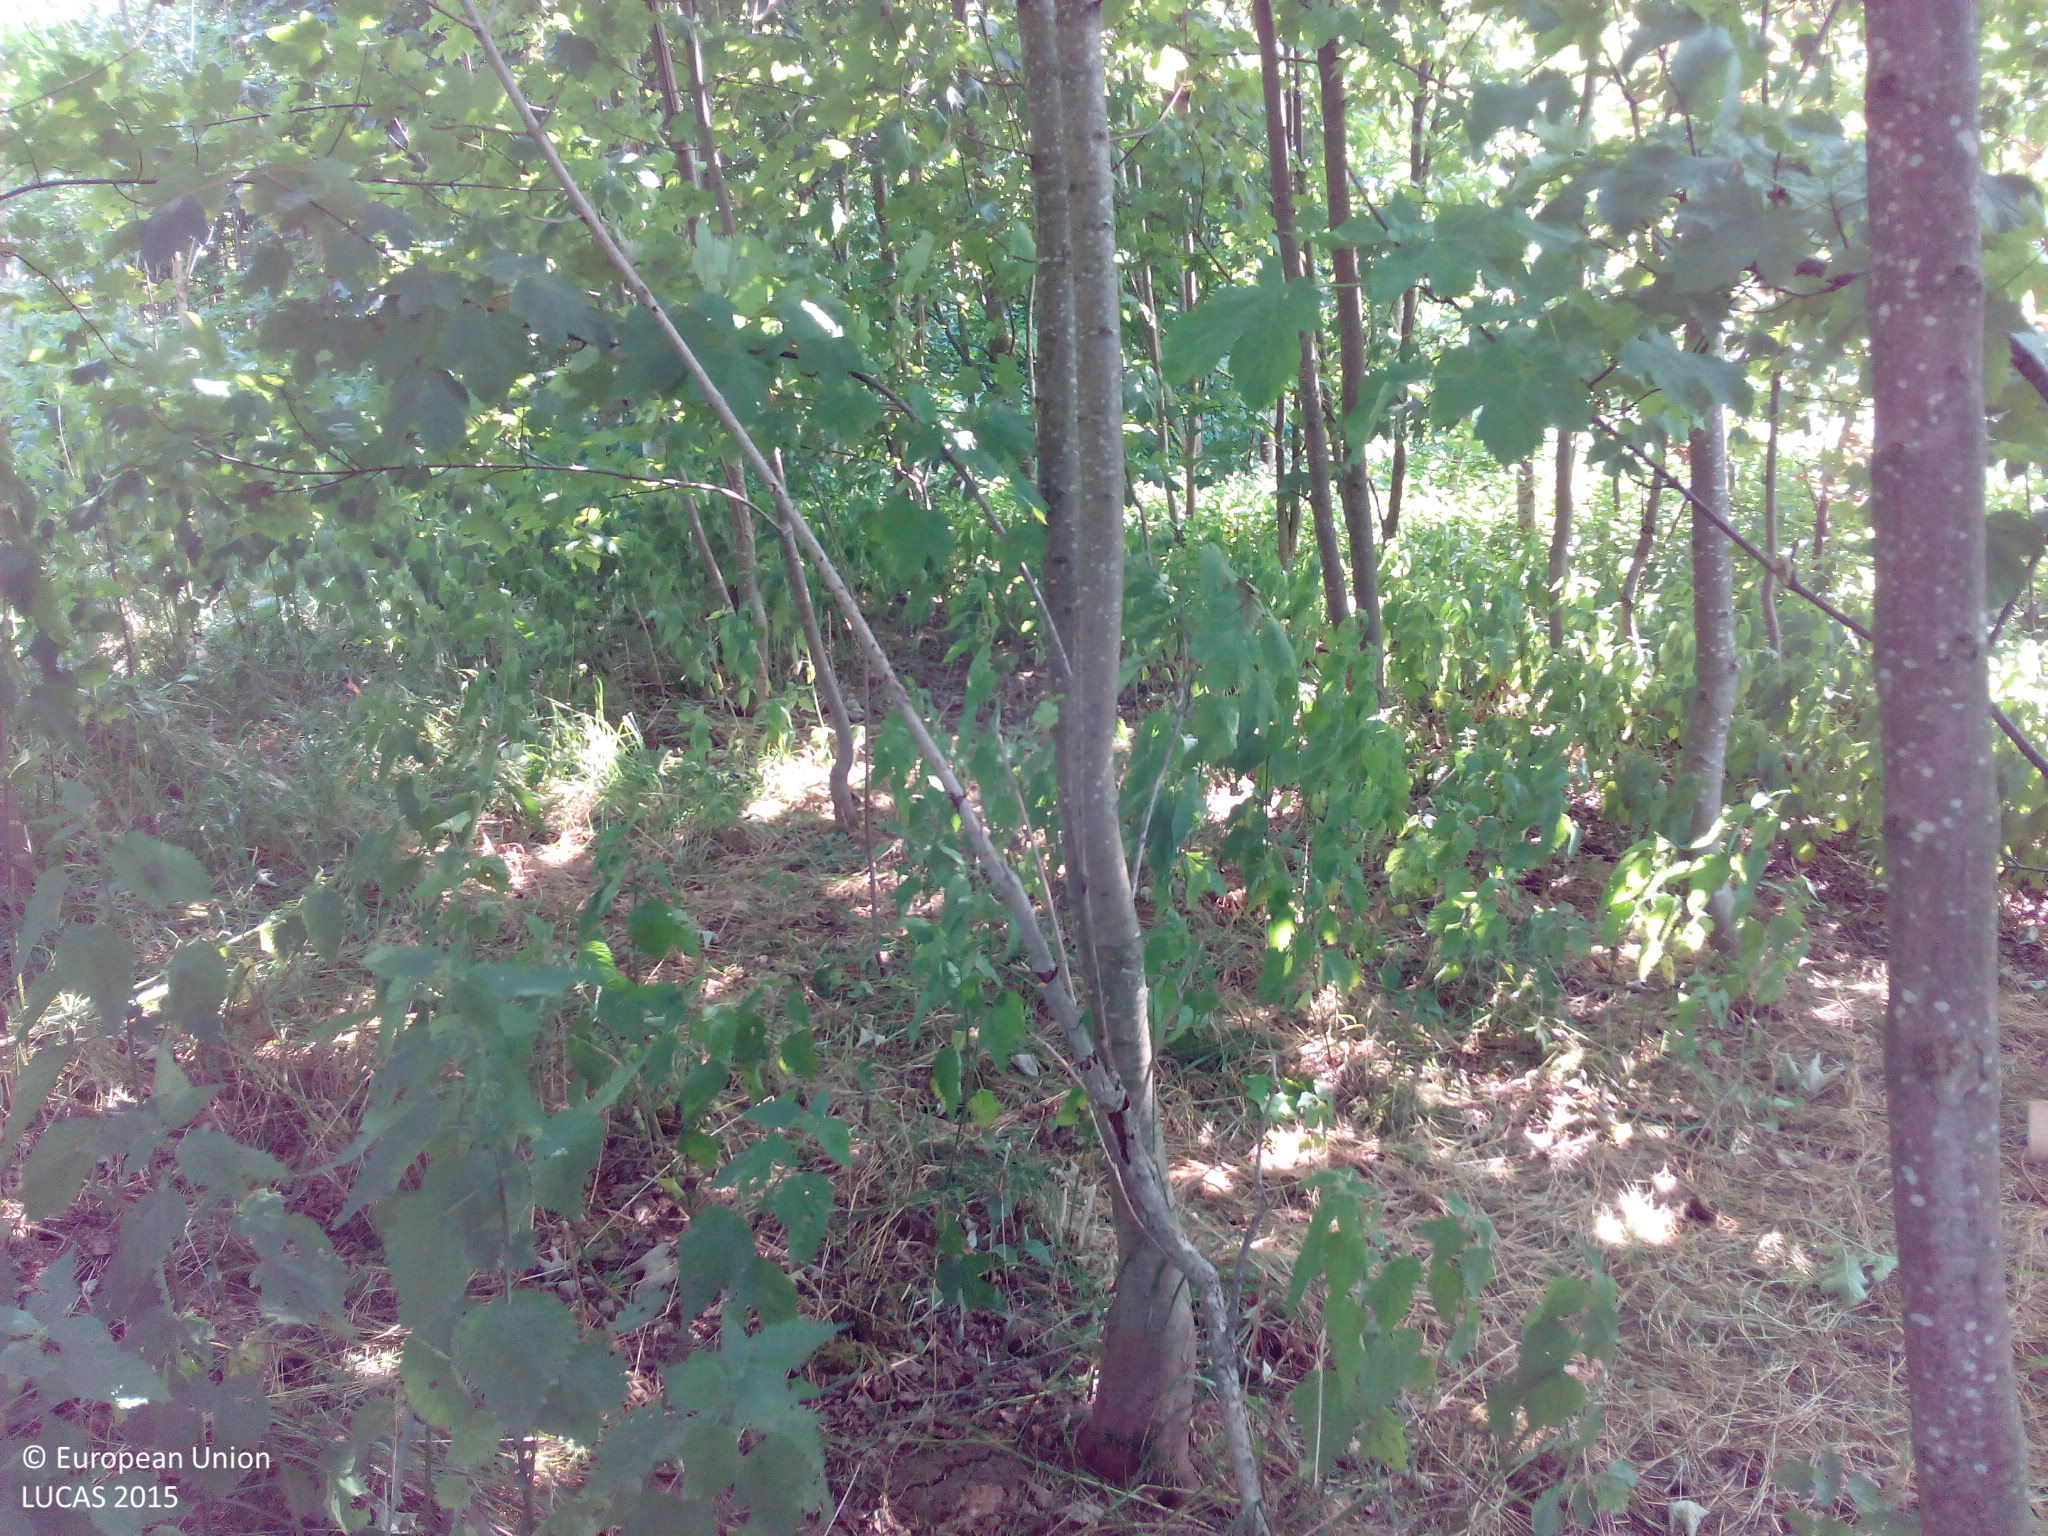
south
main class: Woodland
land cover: Broadleaved woodland
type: mesophytic deciduous forest
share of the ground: 50 - 75 %
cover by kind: broadleaved forest trees 75 %, herbaceous plants 25 %
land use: Forestry
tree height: < 5 m
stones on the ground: < 10 %
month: July
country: DE
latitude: 48.5290
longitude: 9.6887
